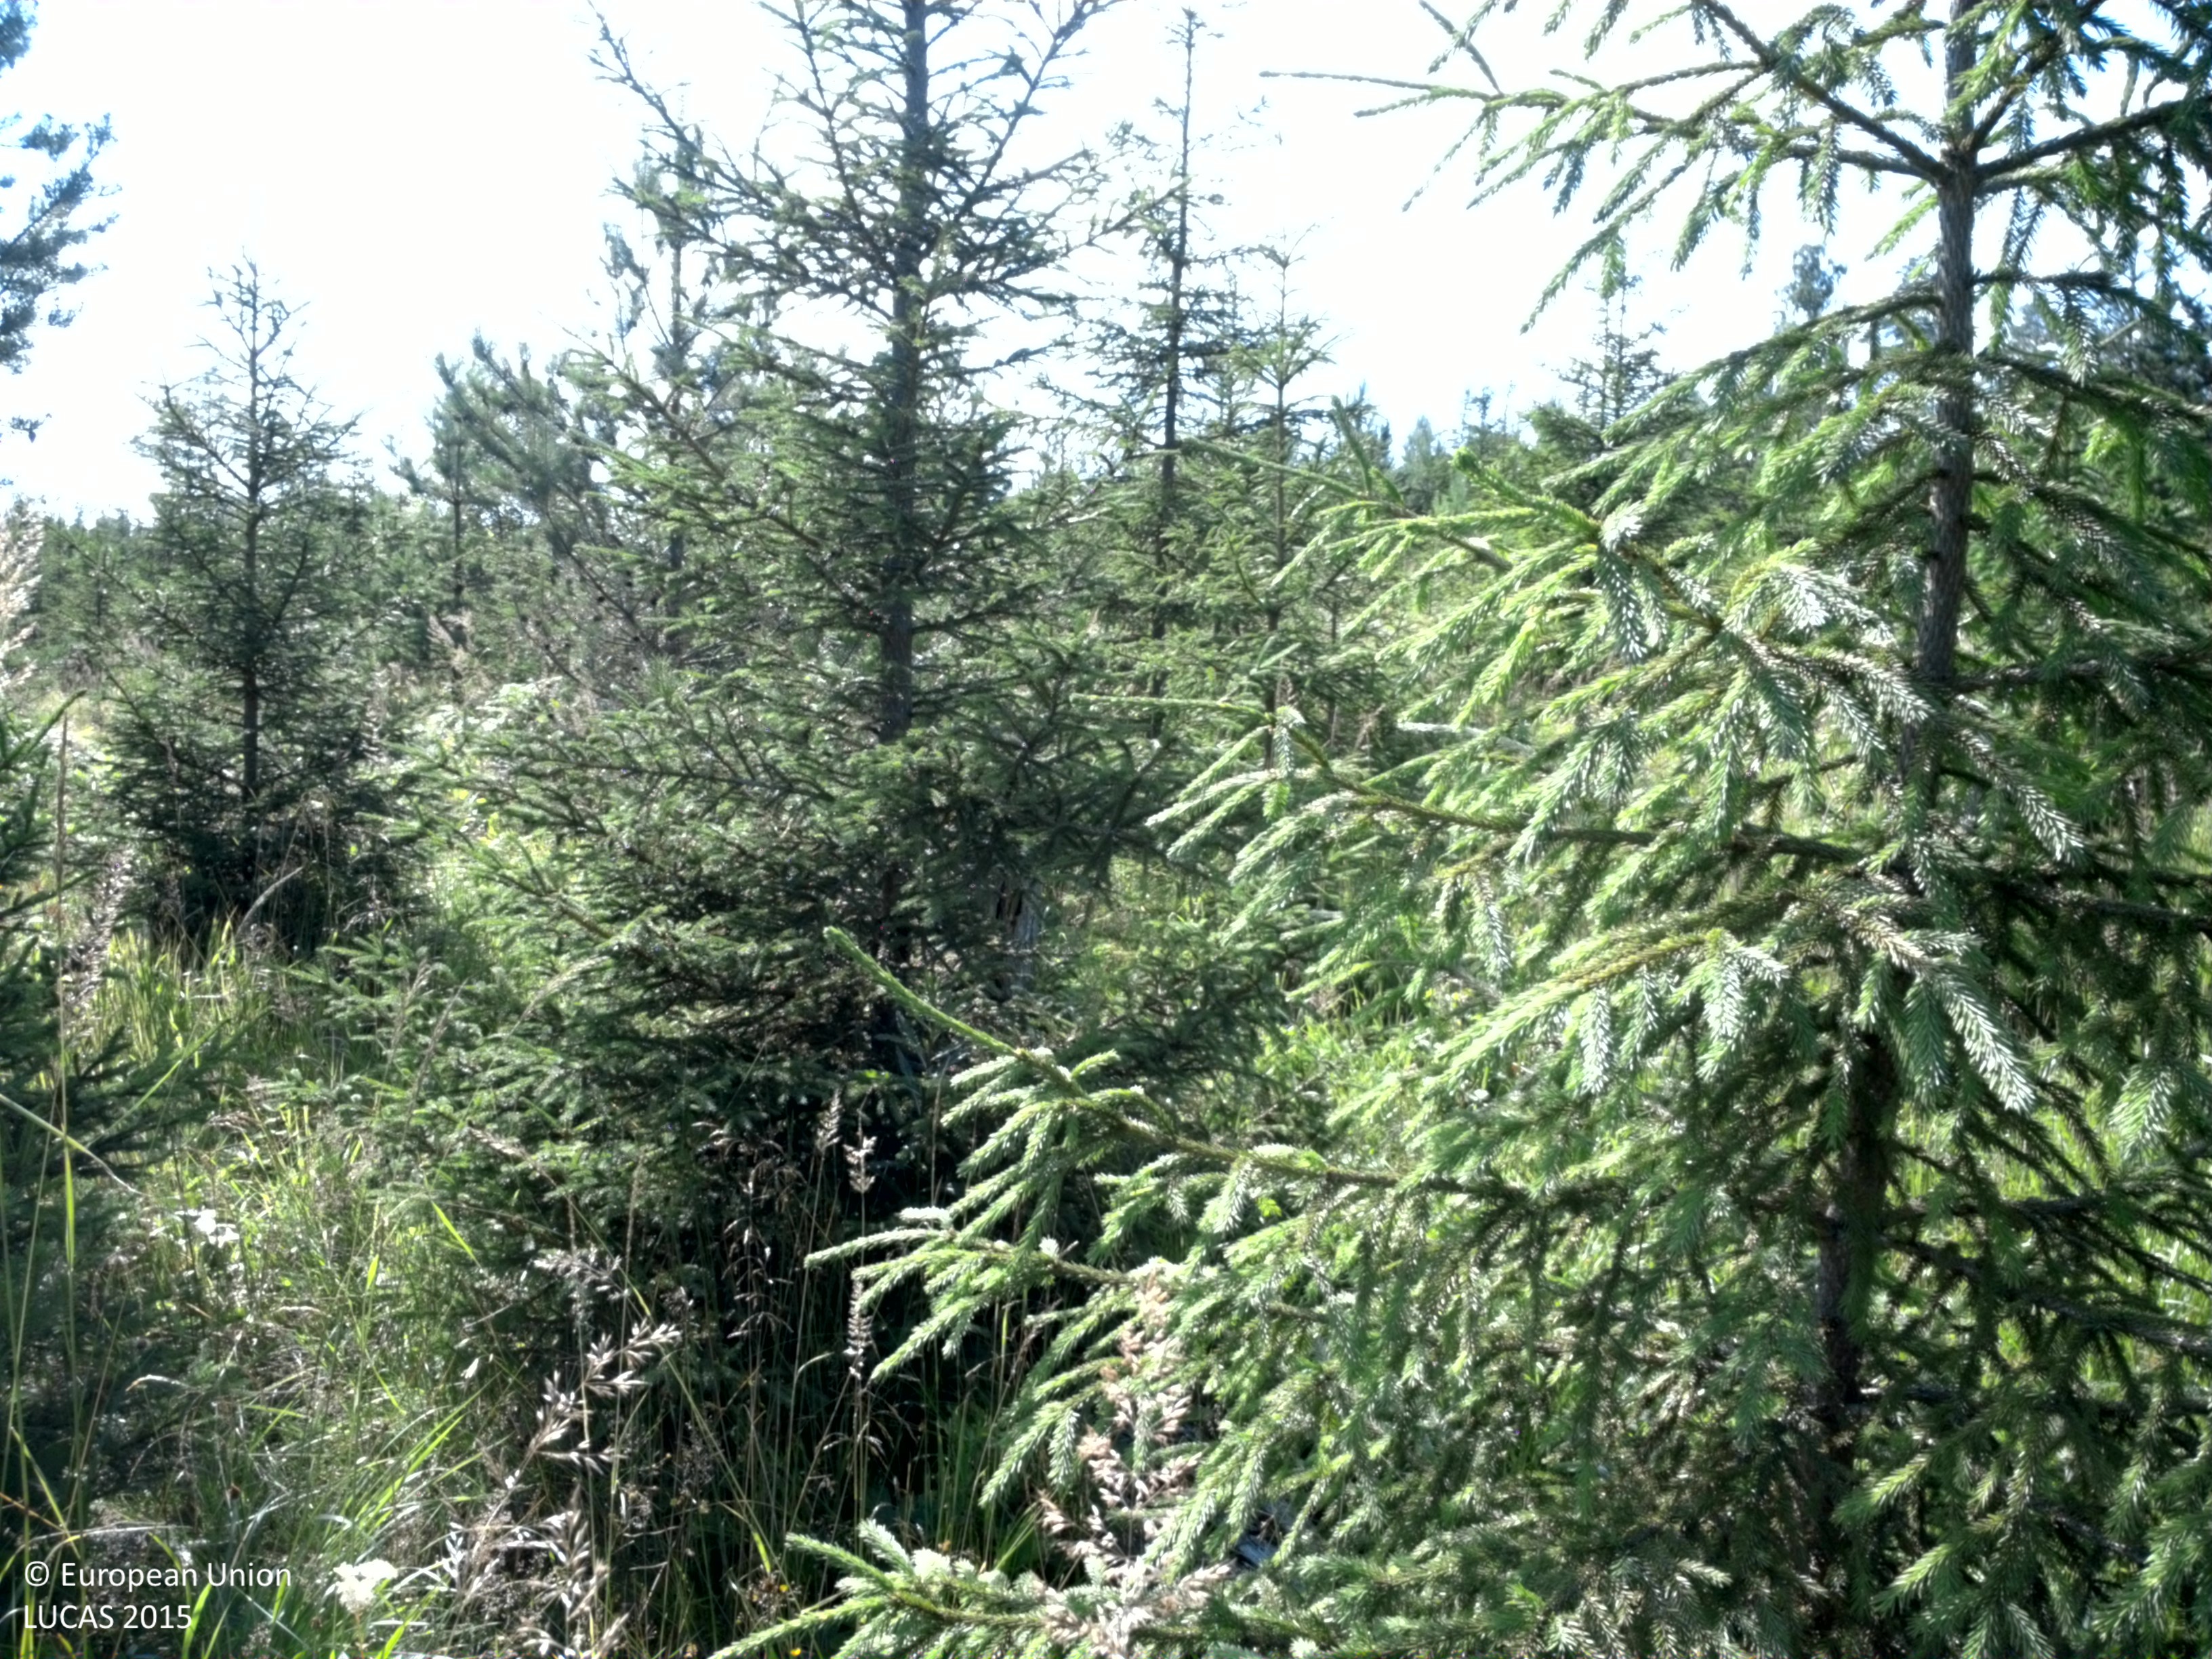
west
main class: Woodland
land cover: Spruce dominated coniferous woodland
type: boreal forest
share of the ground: 25 - 50 %
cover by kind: coniferous forest trees 50 %, herbaceous plants 50 %
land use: Forestry
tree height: < 5 m
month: July
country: SE
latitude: 59.6522
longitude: 18.4989
